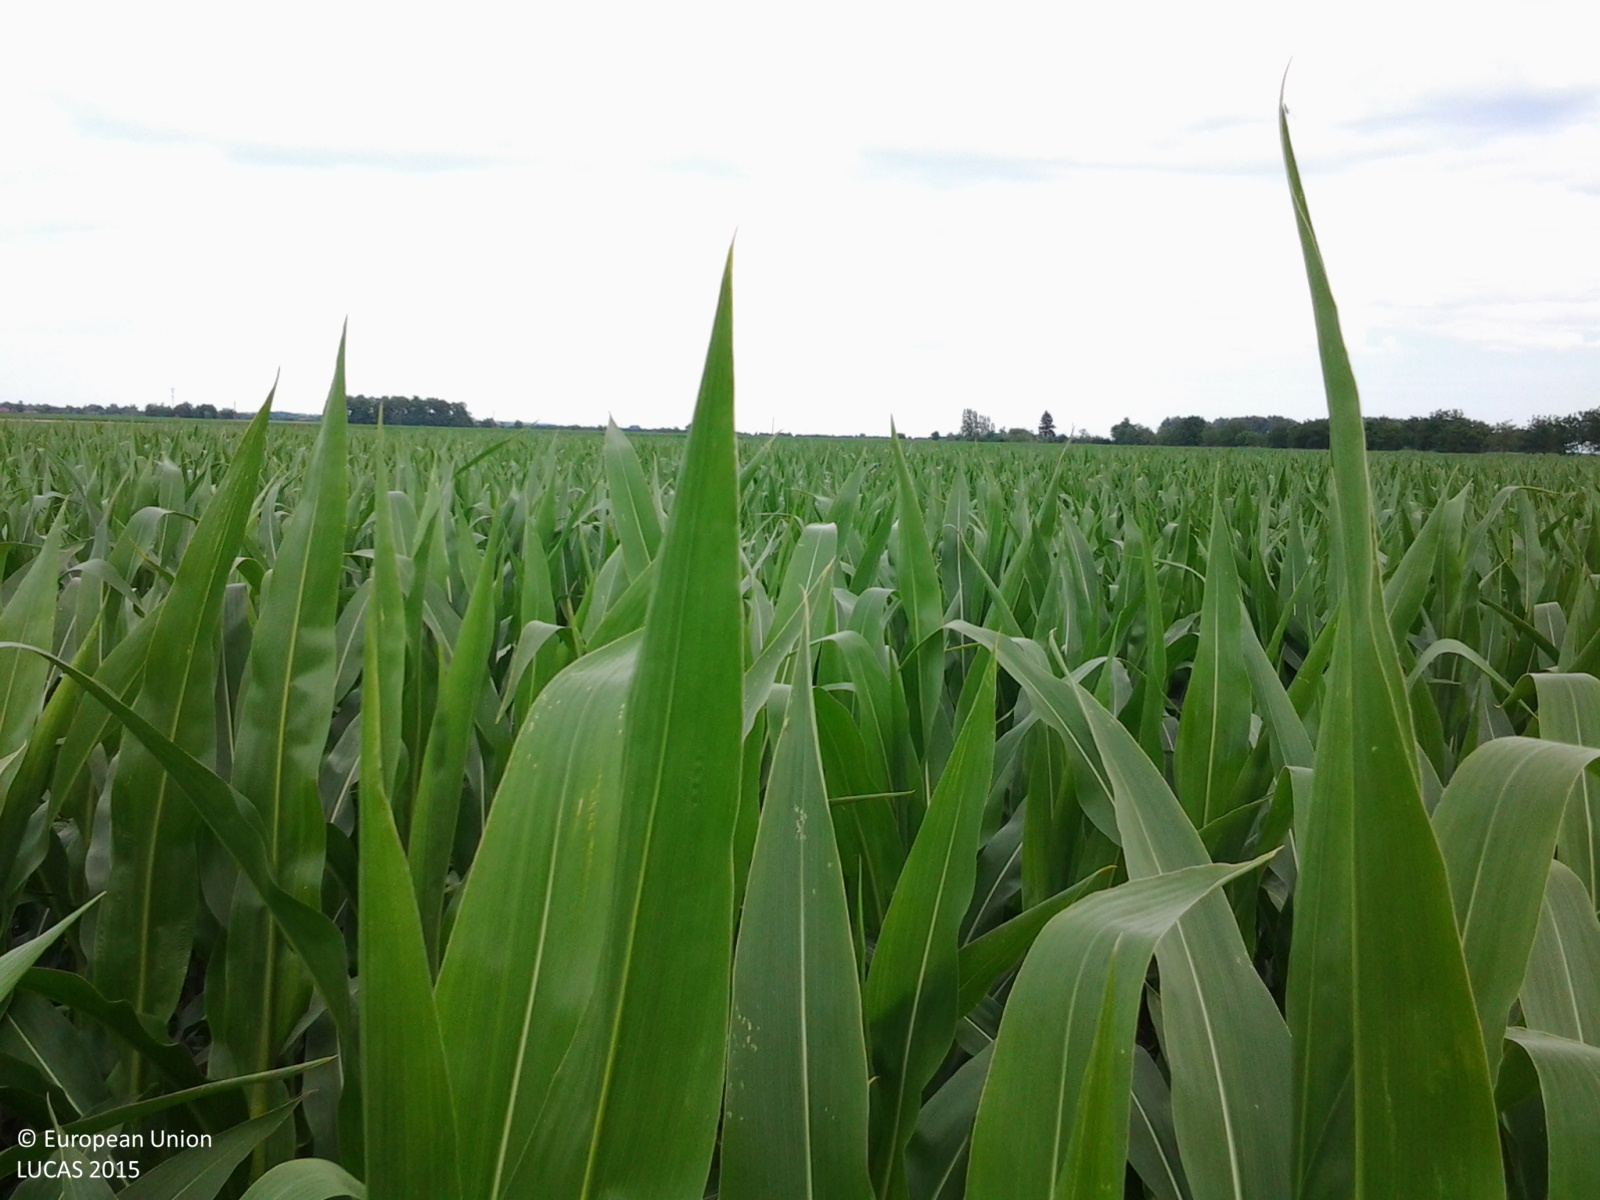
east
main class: Cropland
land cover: Maize
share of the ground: > 75 %
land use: Agriculture (excluding fallow land and kitchen gardens)
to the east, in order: Maize; Common wheat
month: June
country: HU
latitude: 46.4020
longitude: 21.1541
